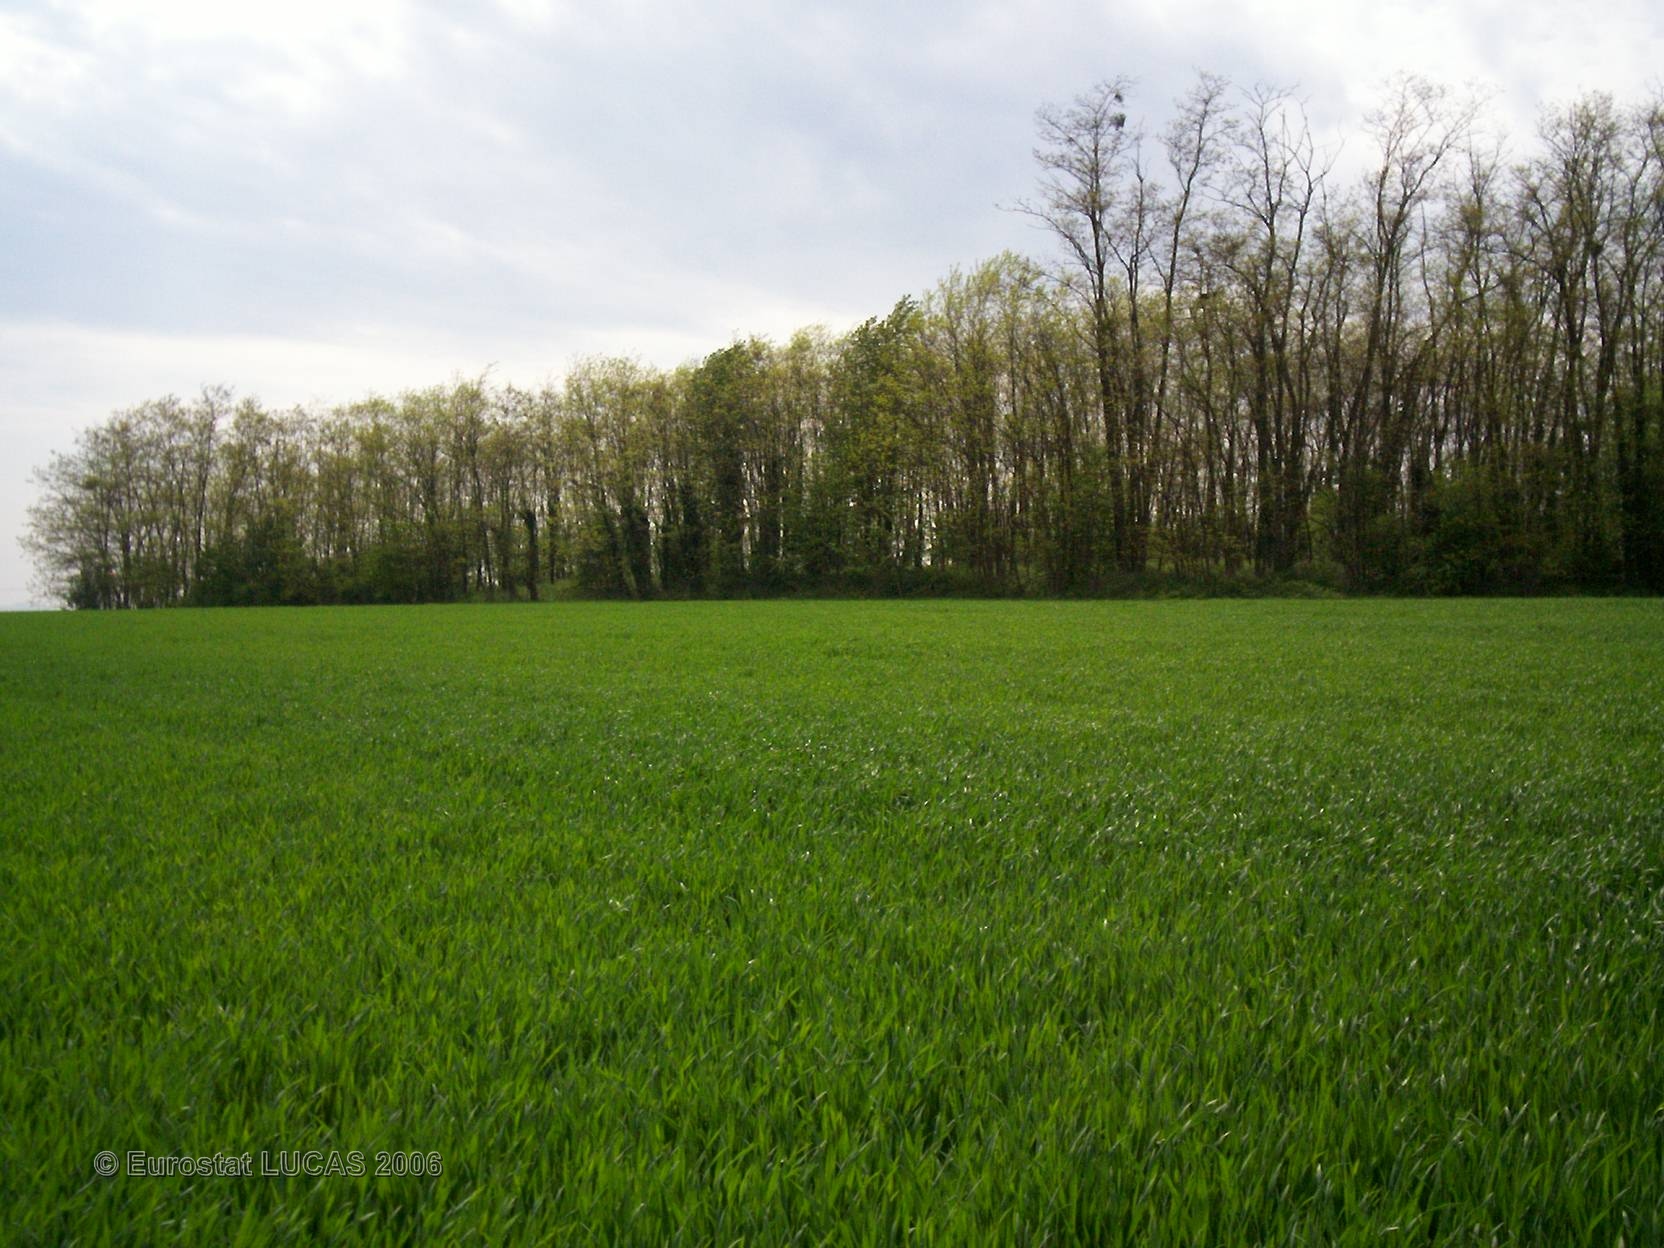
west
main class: Cropland
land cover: Common wheat
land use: Agriculture (excluding fallow land and kitchen gardens)
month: May
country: FR
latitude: 45.9901
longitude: 4.8002
